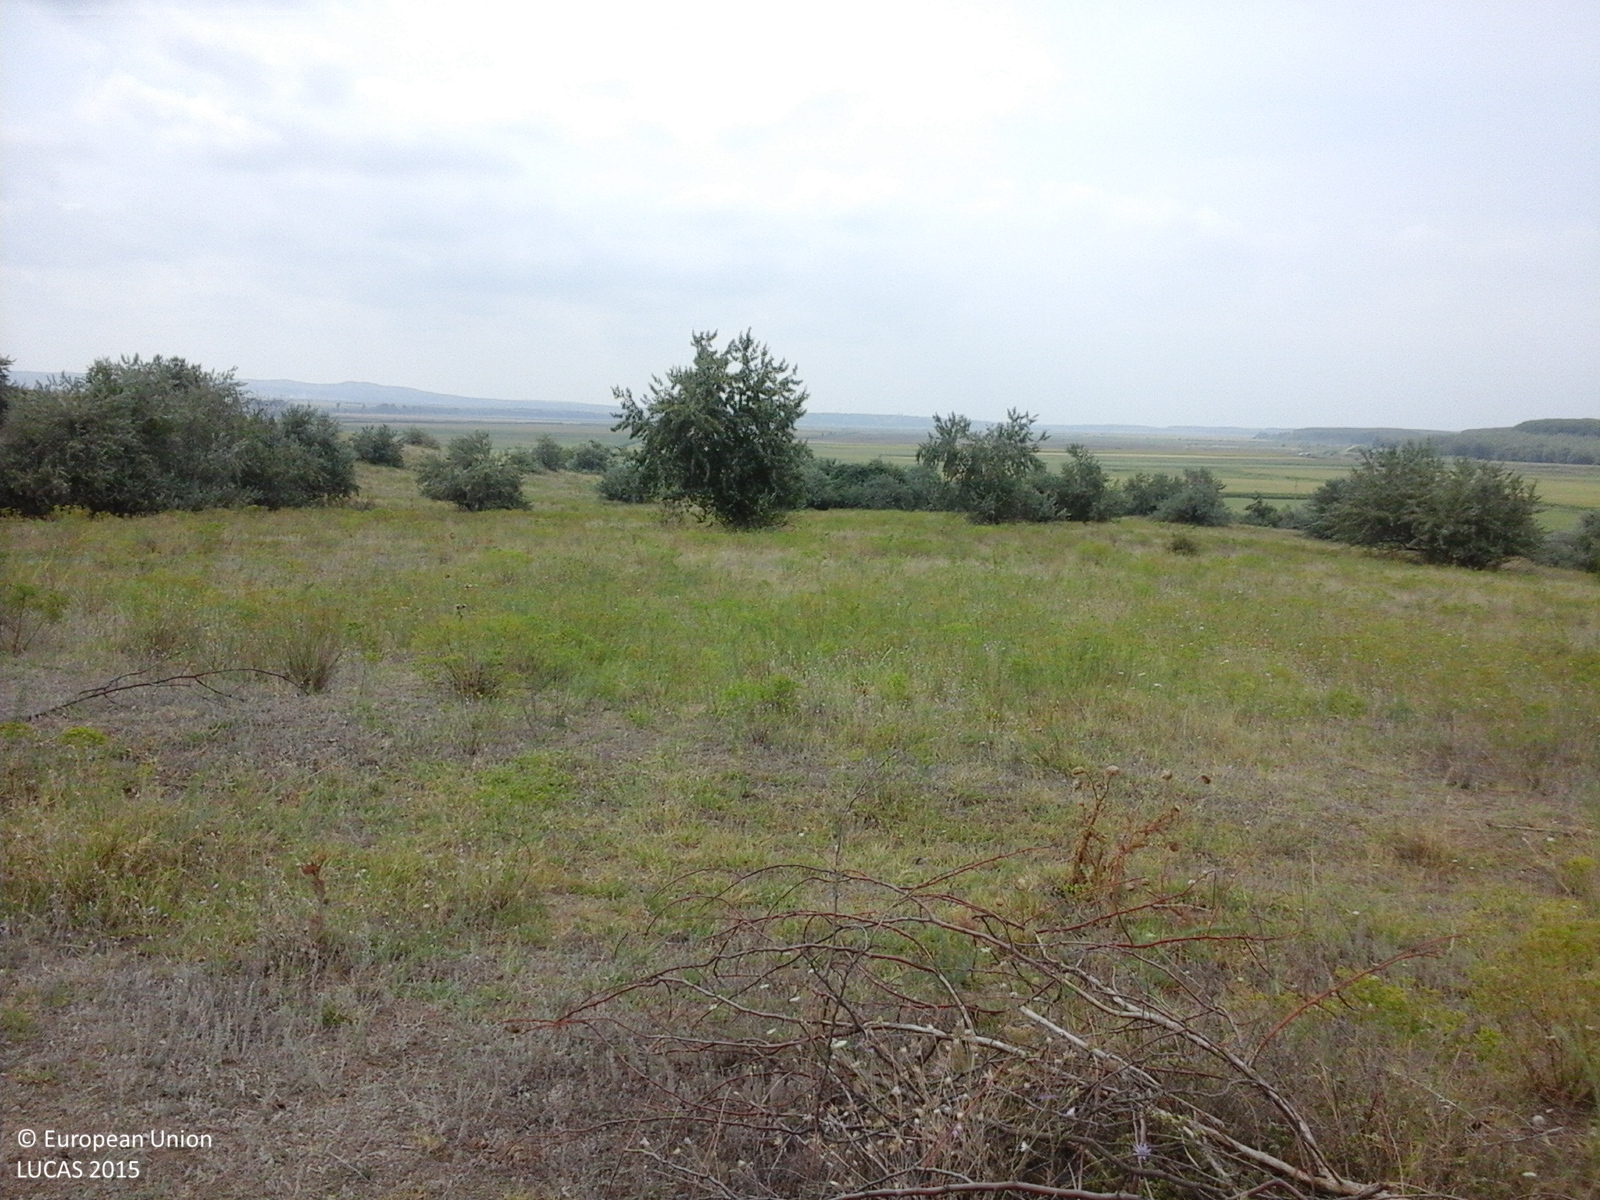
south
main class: Grassland
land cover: Grassland without tree/shrub cover
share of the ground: > 75 %
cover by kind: herbaceous plants 100 %
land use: Agriculture (excluding fallow land and kitchen gardens)
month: July
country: RO
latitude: 44.9818
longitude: 28.1641
